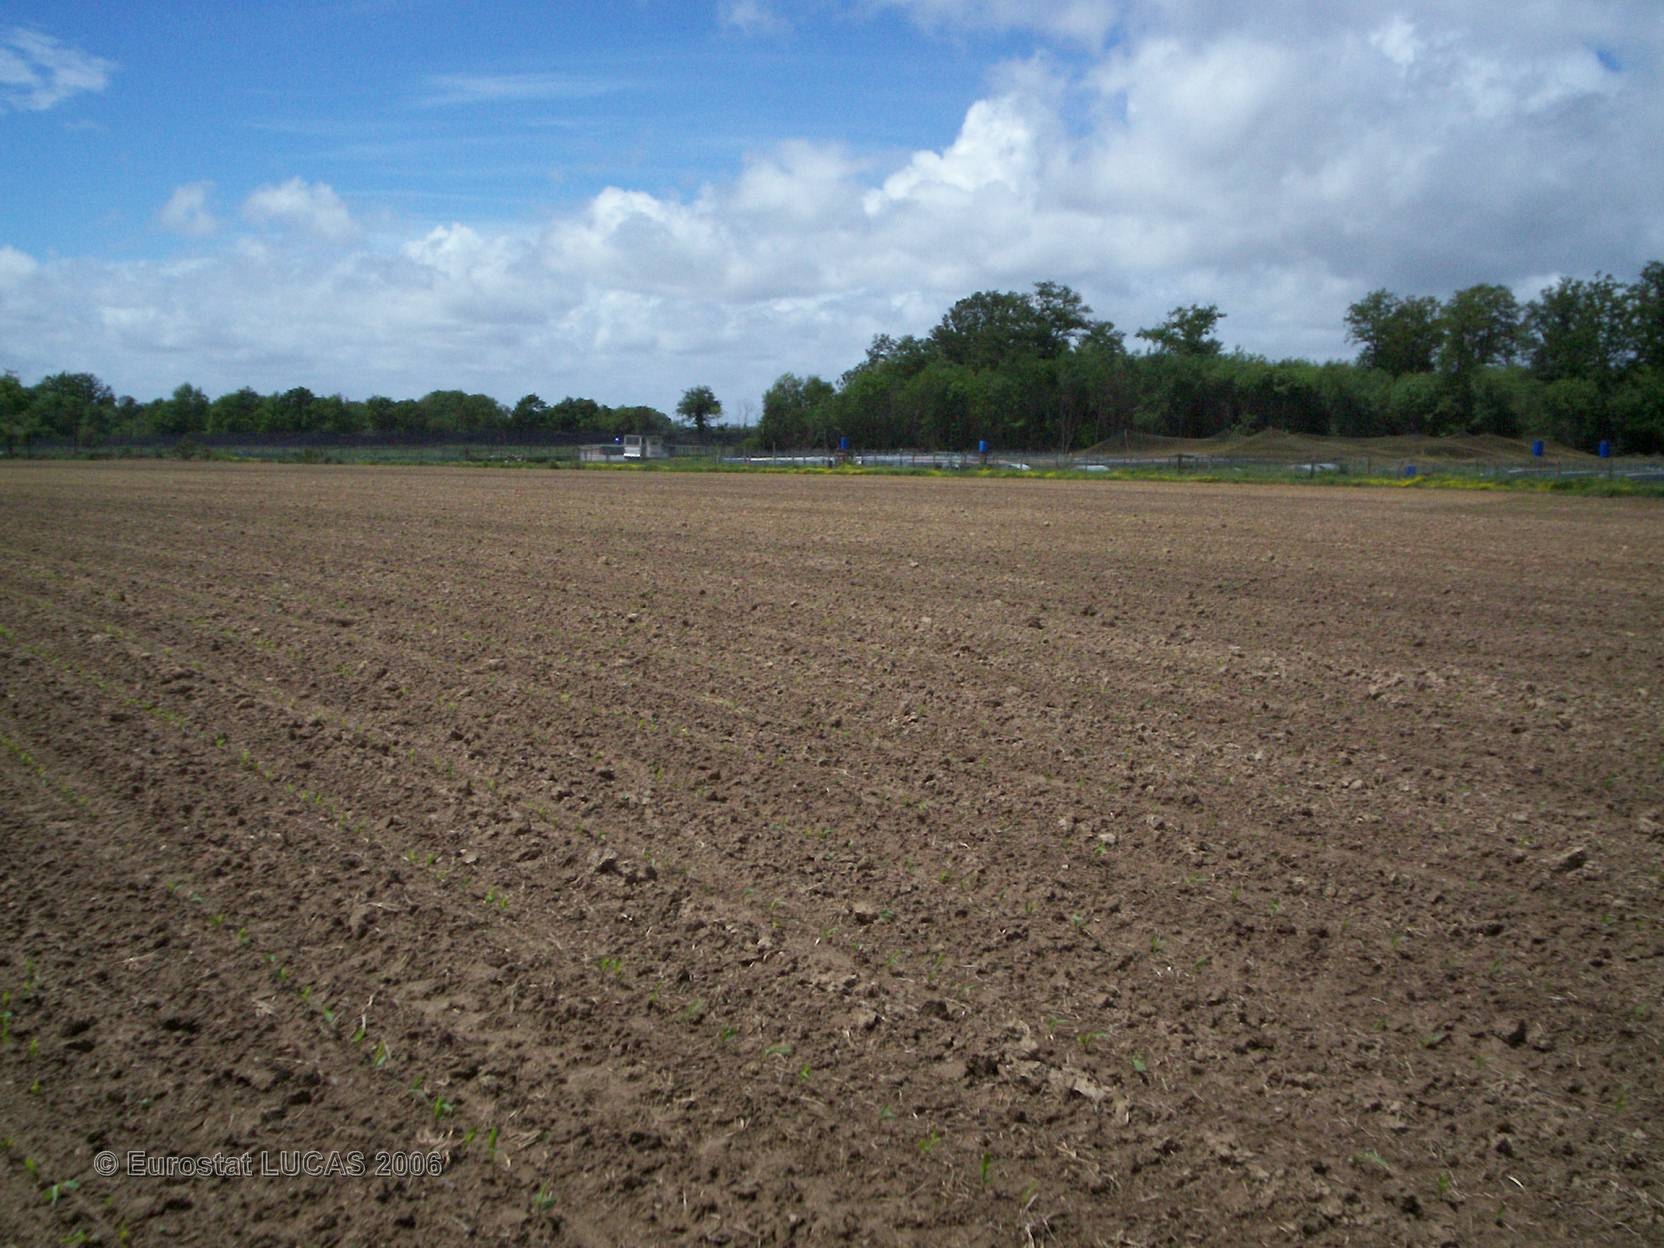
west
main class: Cropland
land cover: Maize
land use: Agriculture (excluding fallow land and kitchen gardens)
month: May
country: FR
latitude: 47.1755
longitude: -1.0530
